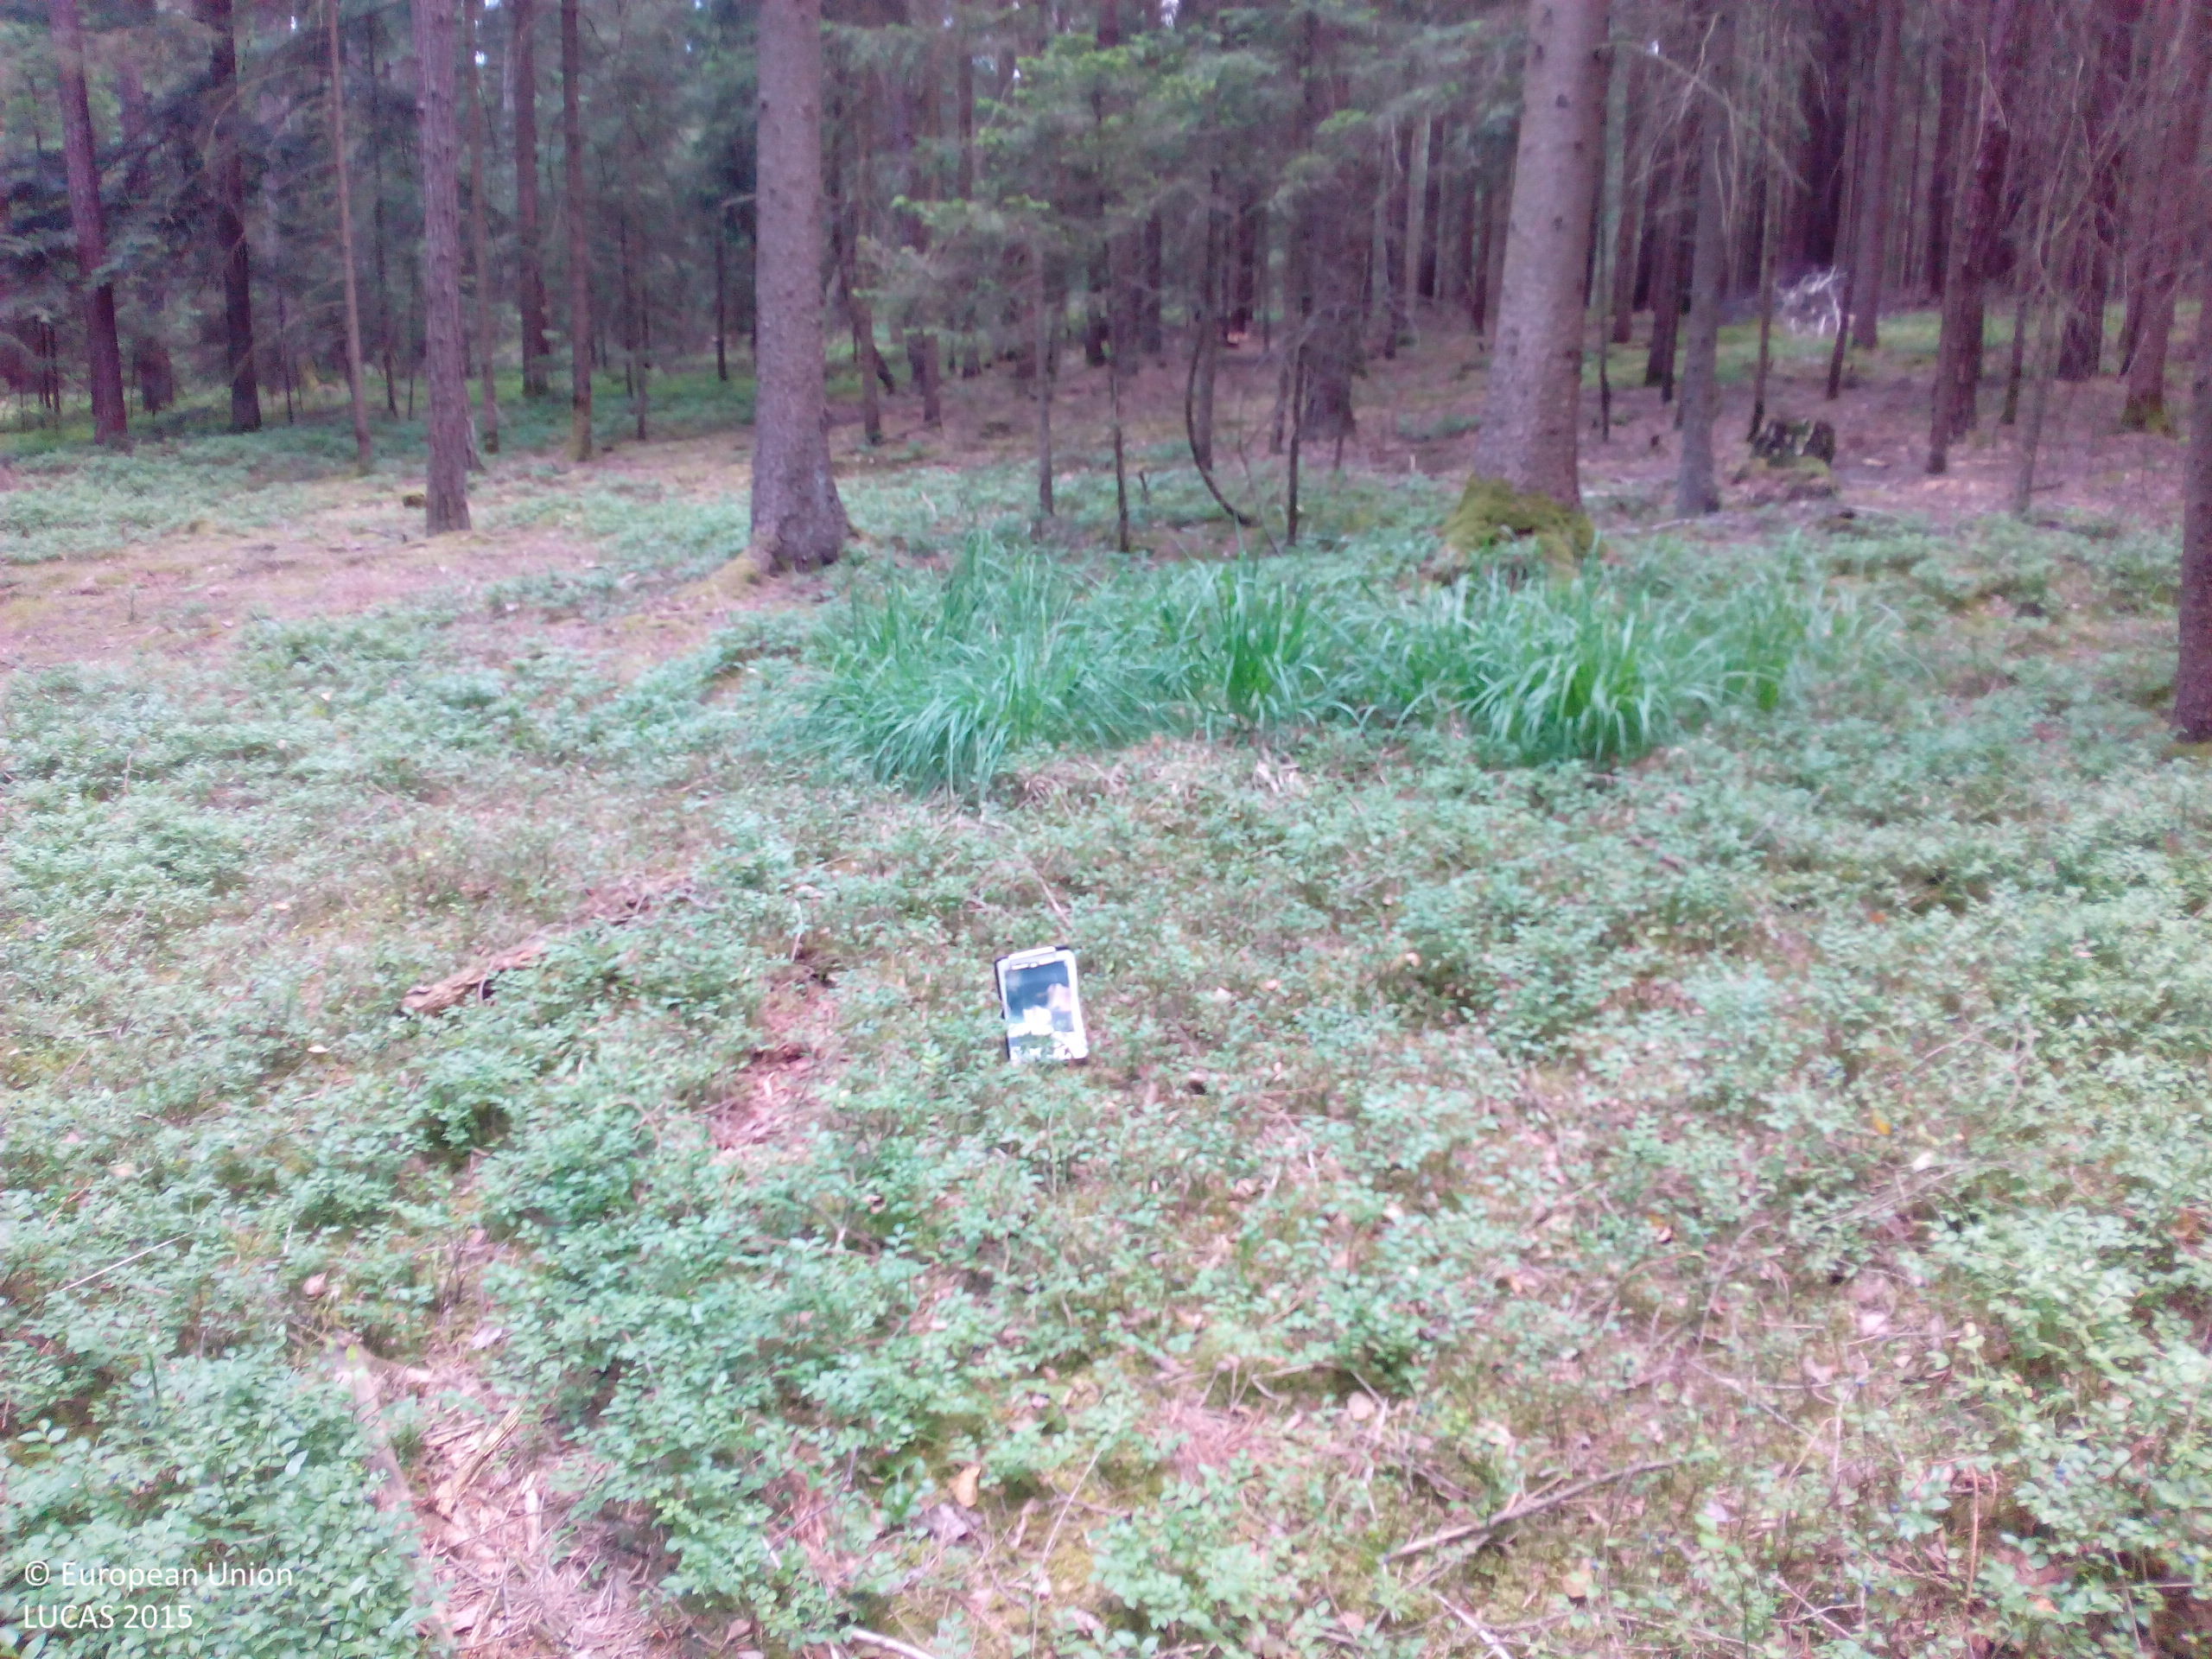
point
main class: Woodland
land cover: Other coniferous woodland
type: hemiboreal forest and nemoral coniferous forest and mixed broadleaved-coniferous forest
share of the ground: 50 - 75 %
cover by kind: coniferous forest trees 55 %, shrubs 20 %, herbaceous plants 10 %, lichens and mosses 10 %, broadleaved forest trees 5 %
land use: Forestry
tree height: > 5 m
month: June
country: DE
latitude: 48.5452
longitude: 12.9116
